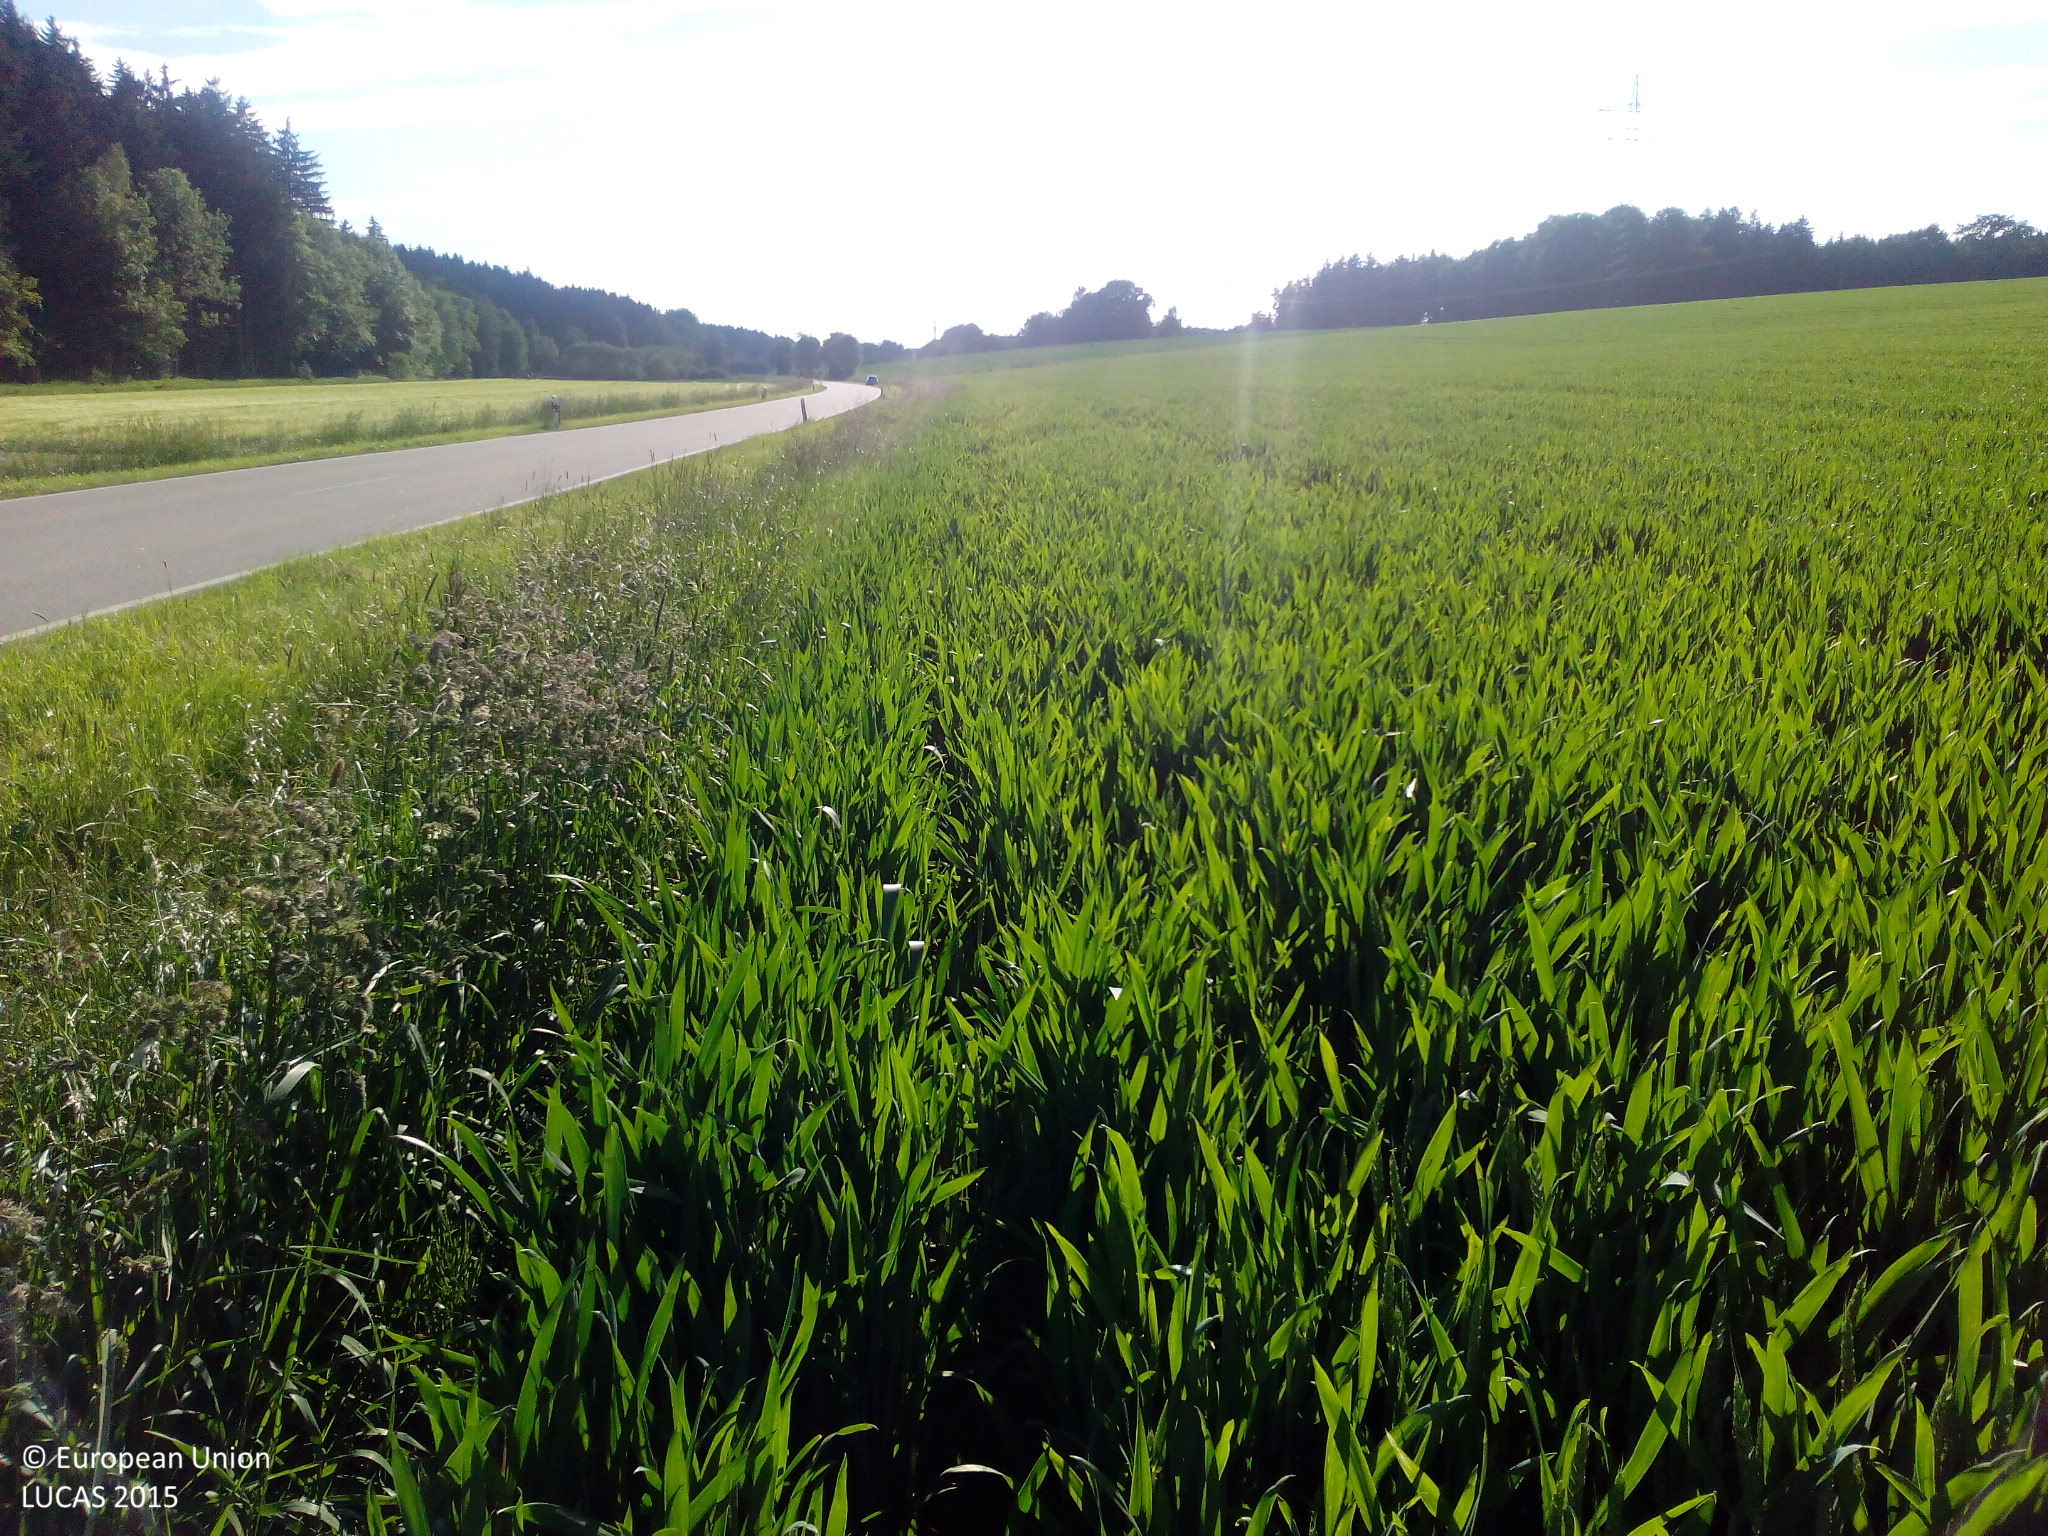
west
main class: Cropland
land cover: Common wheat
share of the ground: > 75 %
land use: Agriculture (excluding fallow land and kitchen gardens)
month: June
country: DE
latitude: 48.7079
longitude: 12.0784
